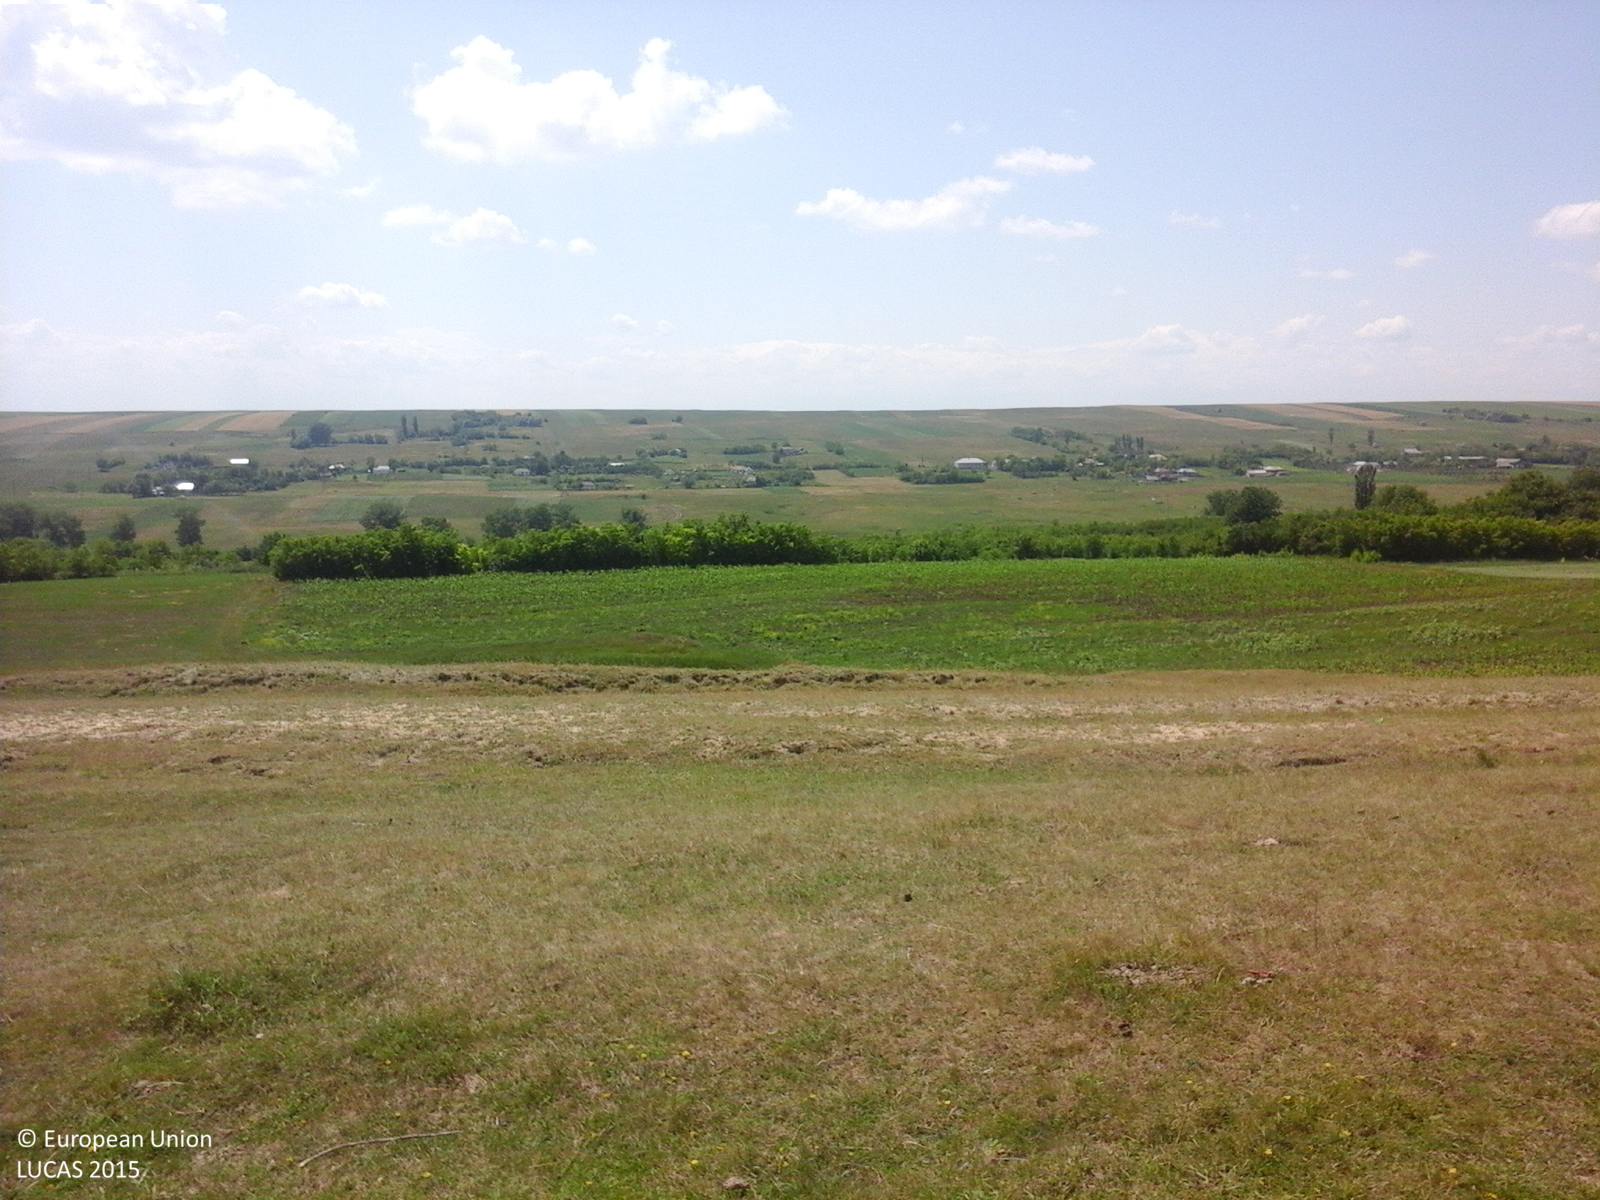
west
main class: Grassland
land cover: Grassland without tree/shrub cover
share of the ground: > 75 %
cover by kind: herbaceous plants 100 %
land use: Agriculture (excluding fallow land and kitchen gardens)
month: June
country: RO
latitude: 48.0375
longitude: 26.7162
